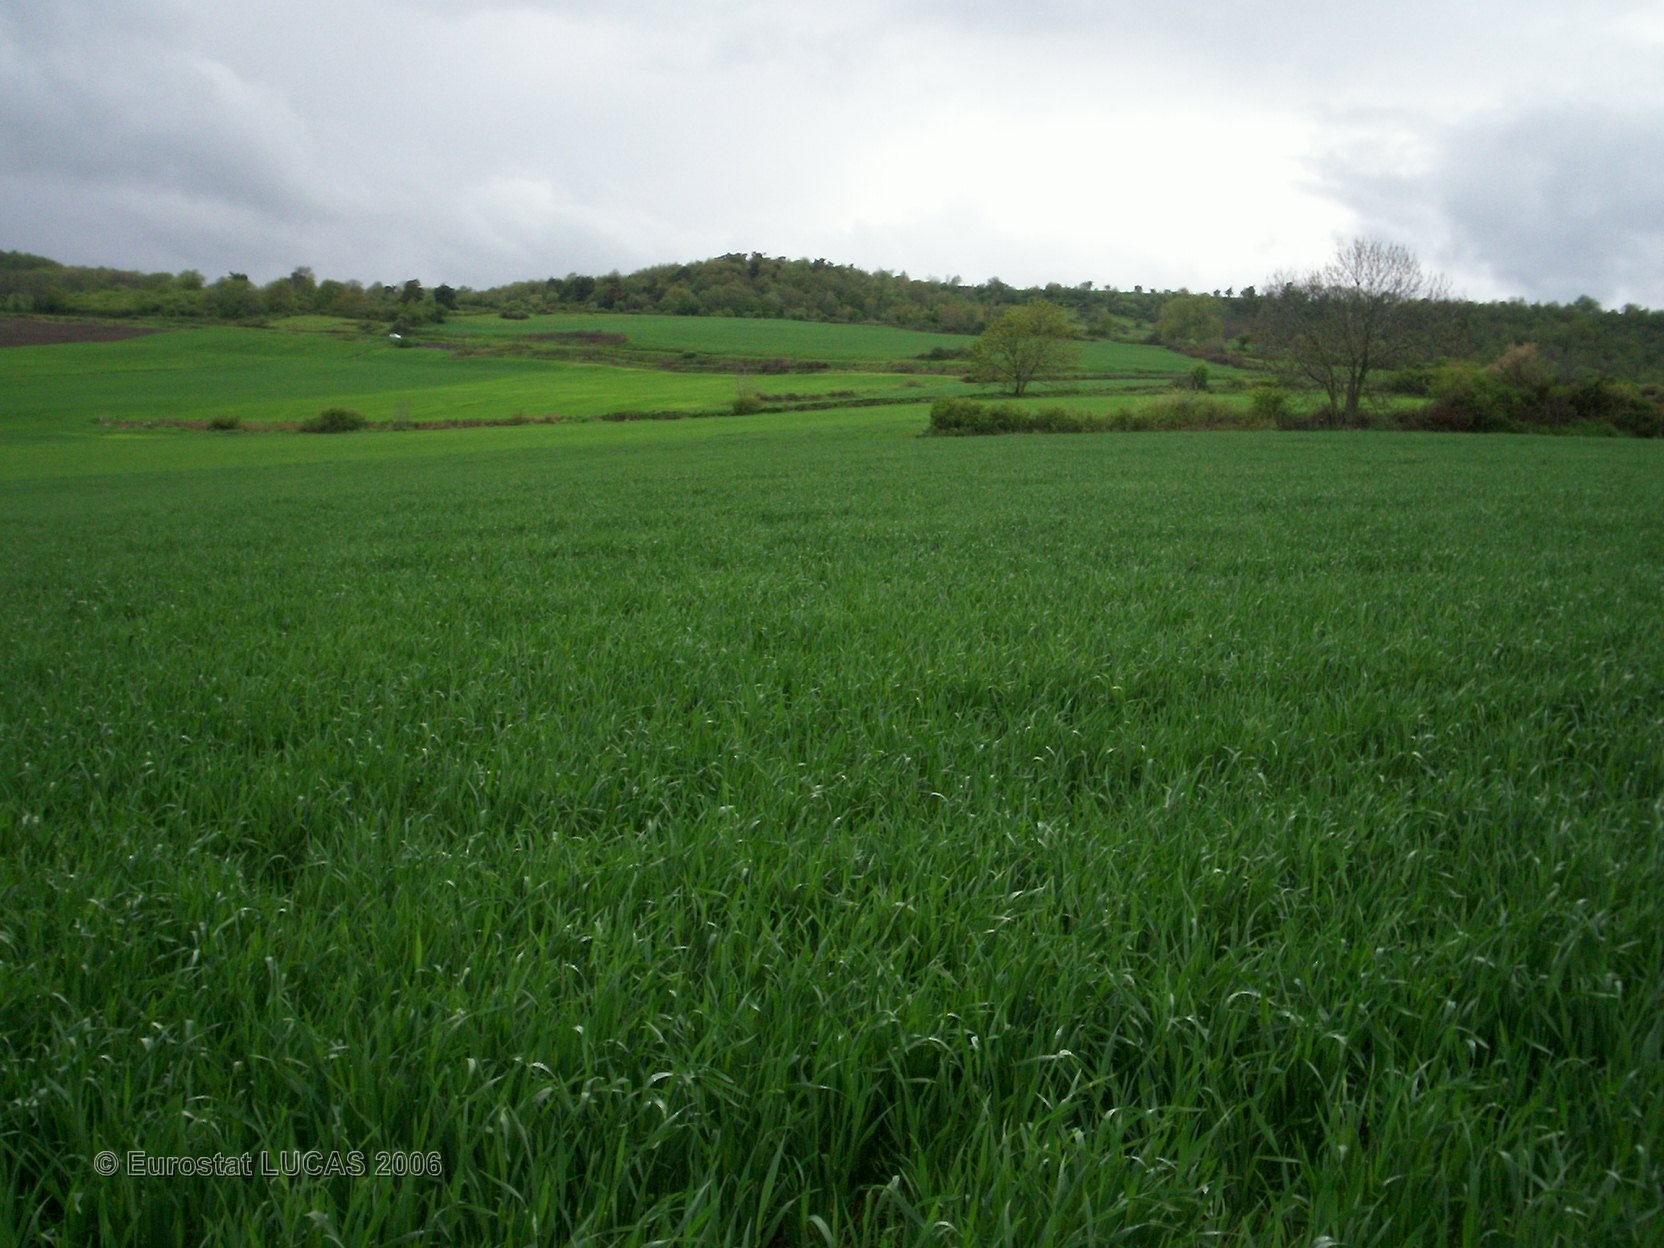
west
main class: Cropland
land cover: Common wheat
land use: Agriculture (excluding fallow land and kitchen gardens)
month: May
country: FR
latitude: 45.4974
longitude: 3.1287
